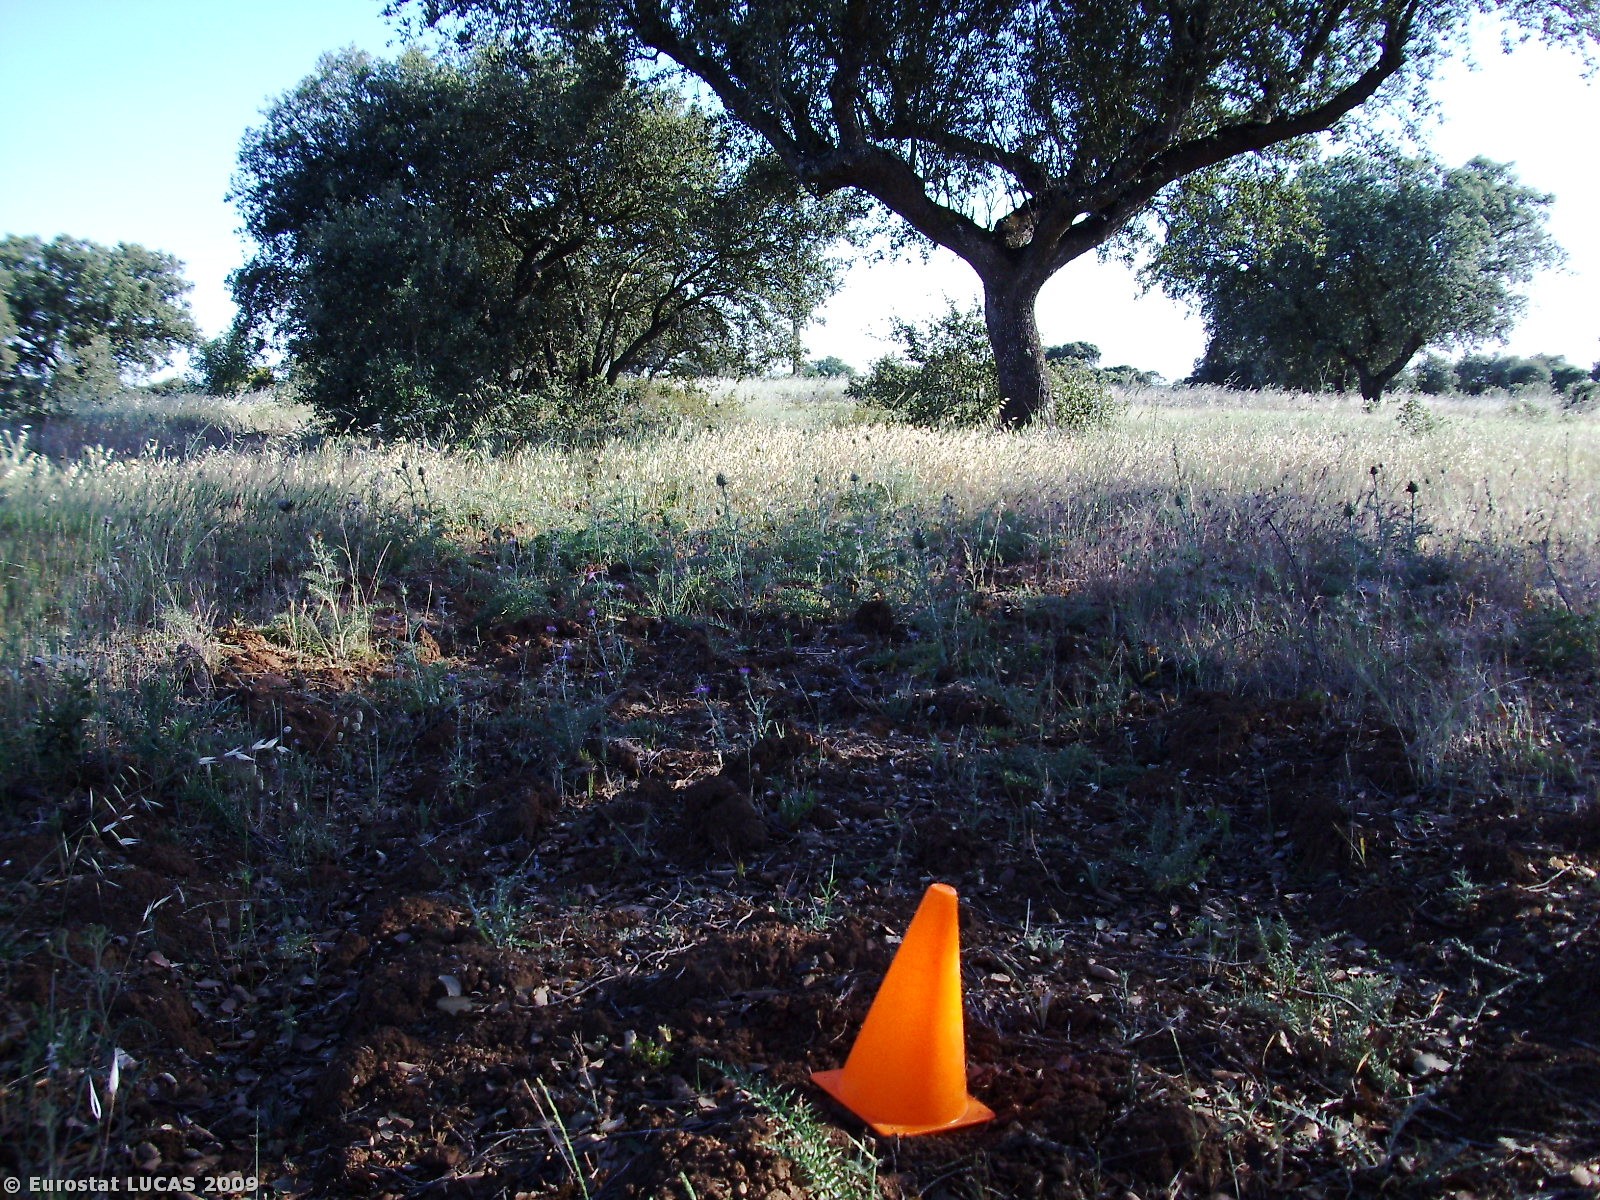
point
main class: Woodland
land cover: Broadleaved woodland
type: broadleaved evergreen forest
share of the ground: 25 - 50 %
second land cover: Spontaneously vegetated surfaces
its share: 50 - 75 %
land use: Forestry
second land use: Fallow land
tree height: > 5 m
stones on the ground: 10 - 25 %
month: May
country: PT
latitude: 38.9870
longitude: -7.3391
